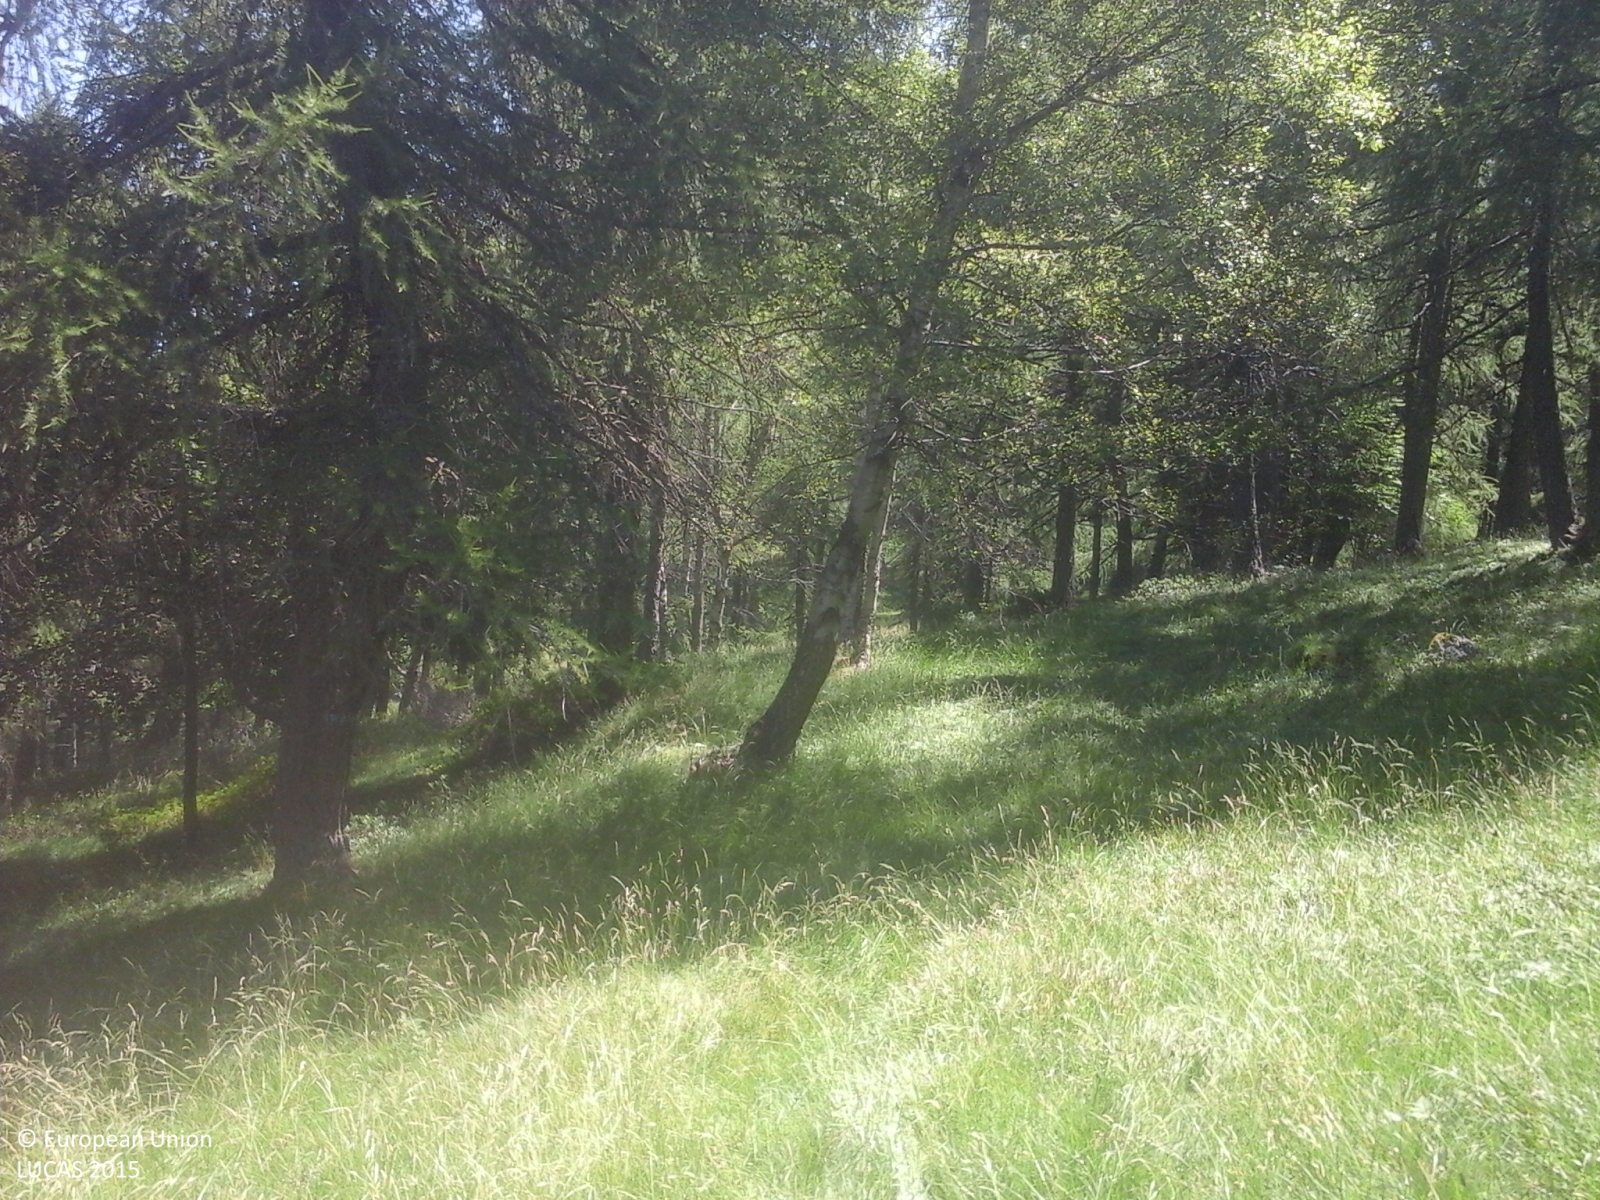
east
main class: Woodland
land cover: Spruce dominated mixed woodland
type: alpine coniferous forest
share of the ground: > 75 %
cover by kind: coniferous forest trees 65 %, broadleaved forest trees 25 %, herbaceous plants 10 %
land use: Forestry
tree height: > 5 m
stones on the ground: < 10 %
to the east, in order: Spruce dominated mixed woodland; Grassland without tree/shrub cover; Other mixed woodland
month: July
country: IT
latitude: 46.0971
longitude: 9.3671
